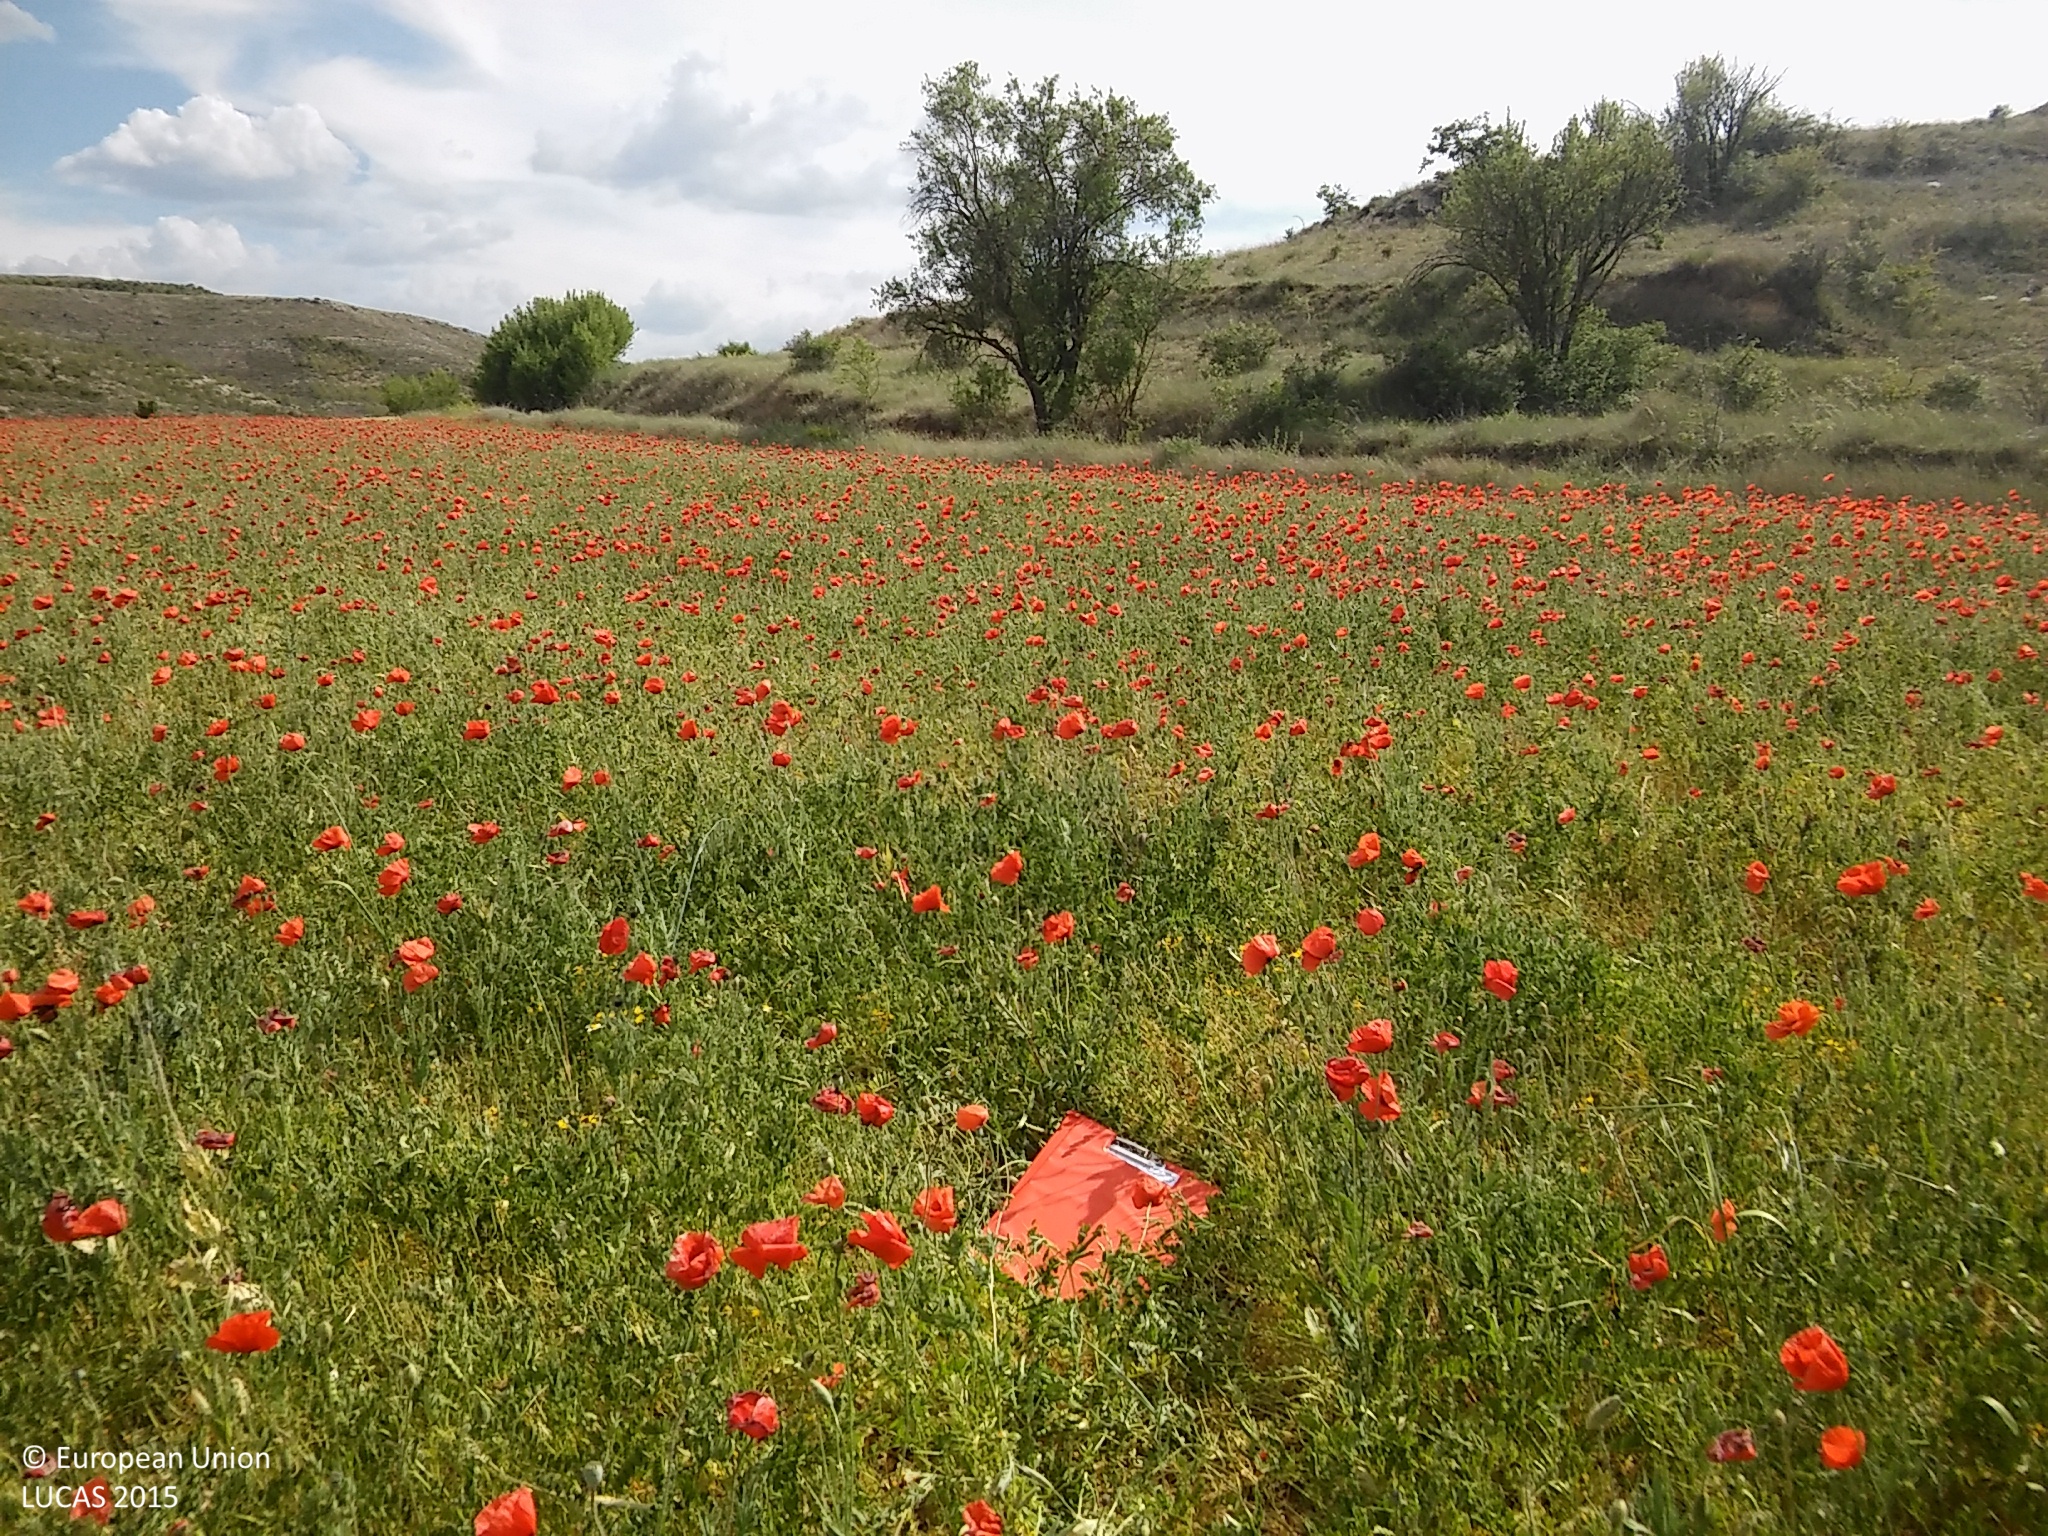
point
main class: Cropland
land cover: Dry pulses
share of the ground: > 75 %
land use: Agriculture (excluding fallow land and kitchen gardens)
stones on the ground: 10 - 25 %
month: June
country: ES
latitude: 41.5782
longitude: -3.7861
